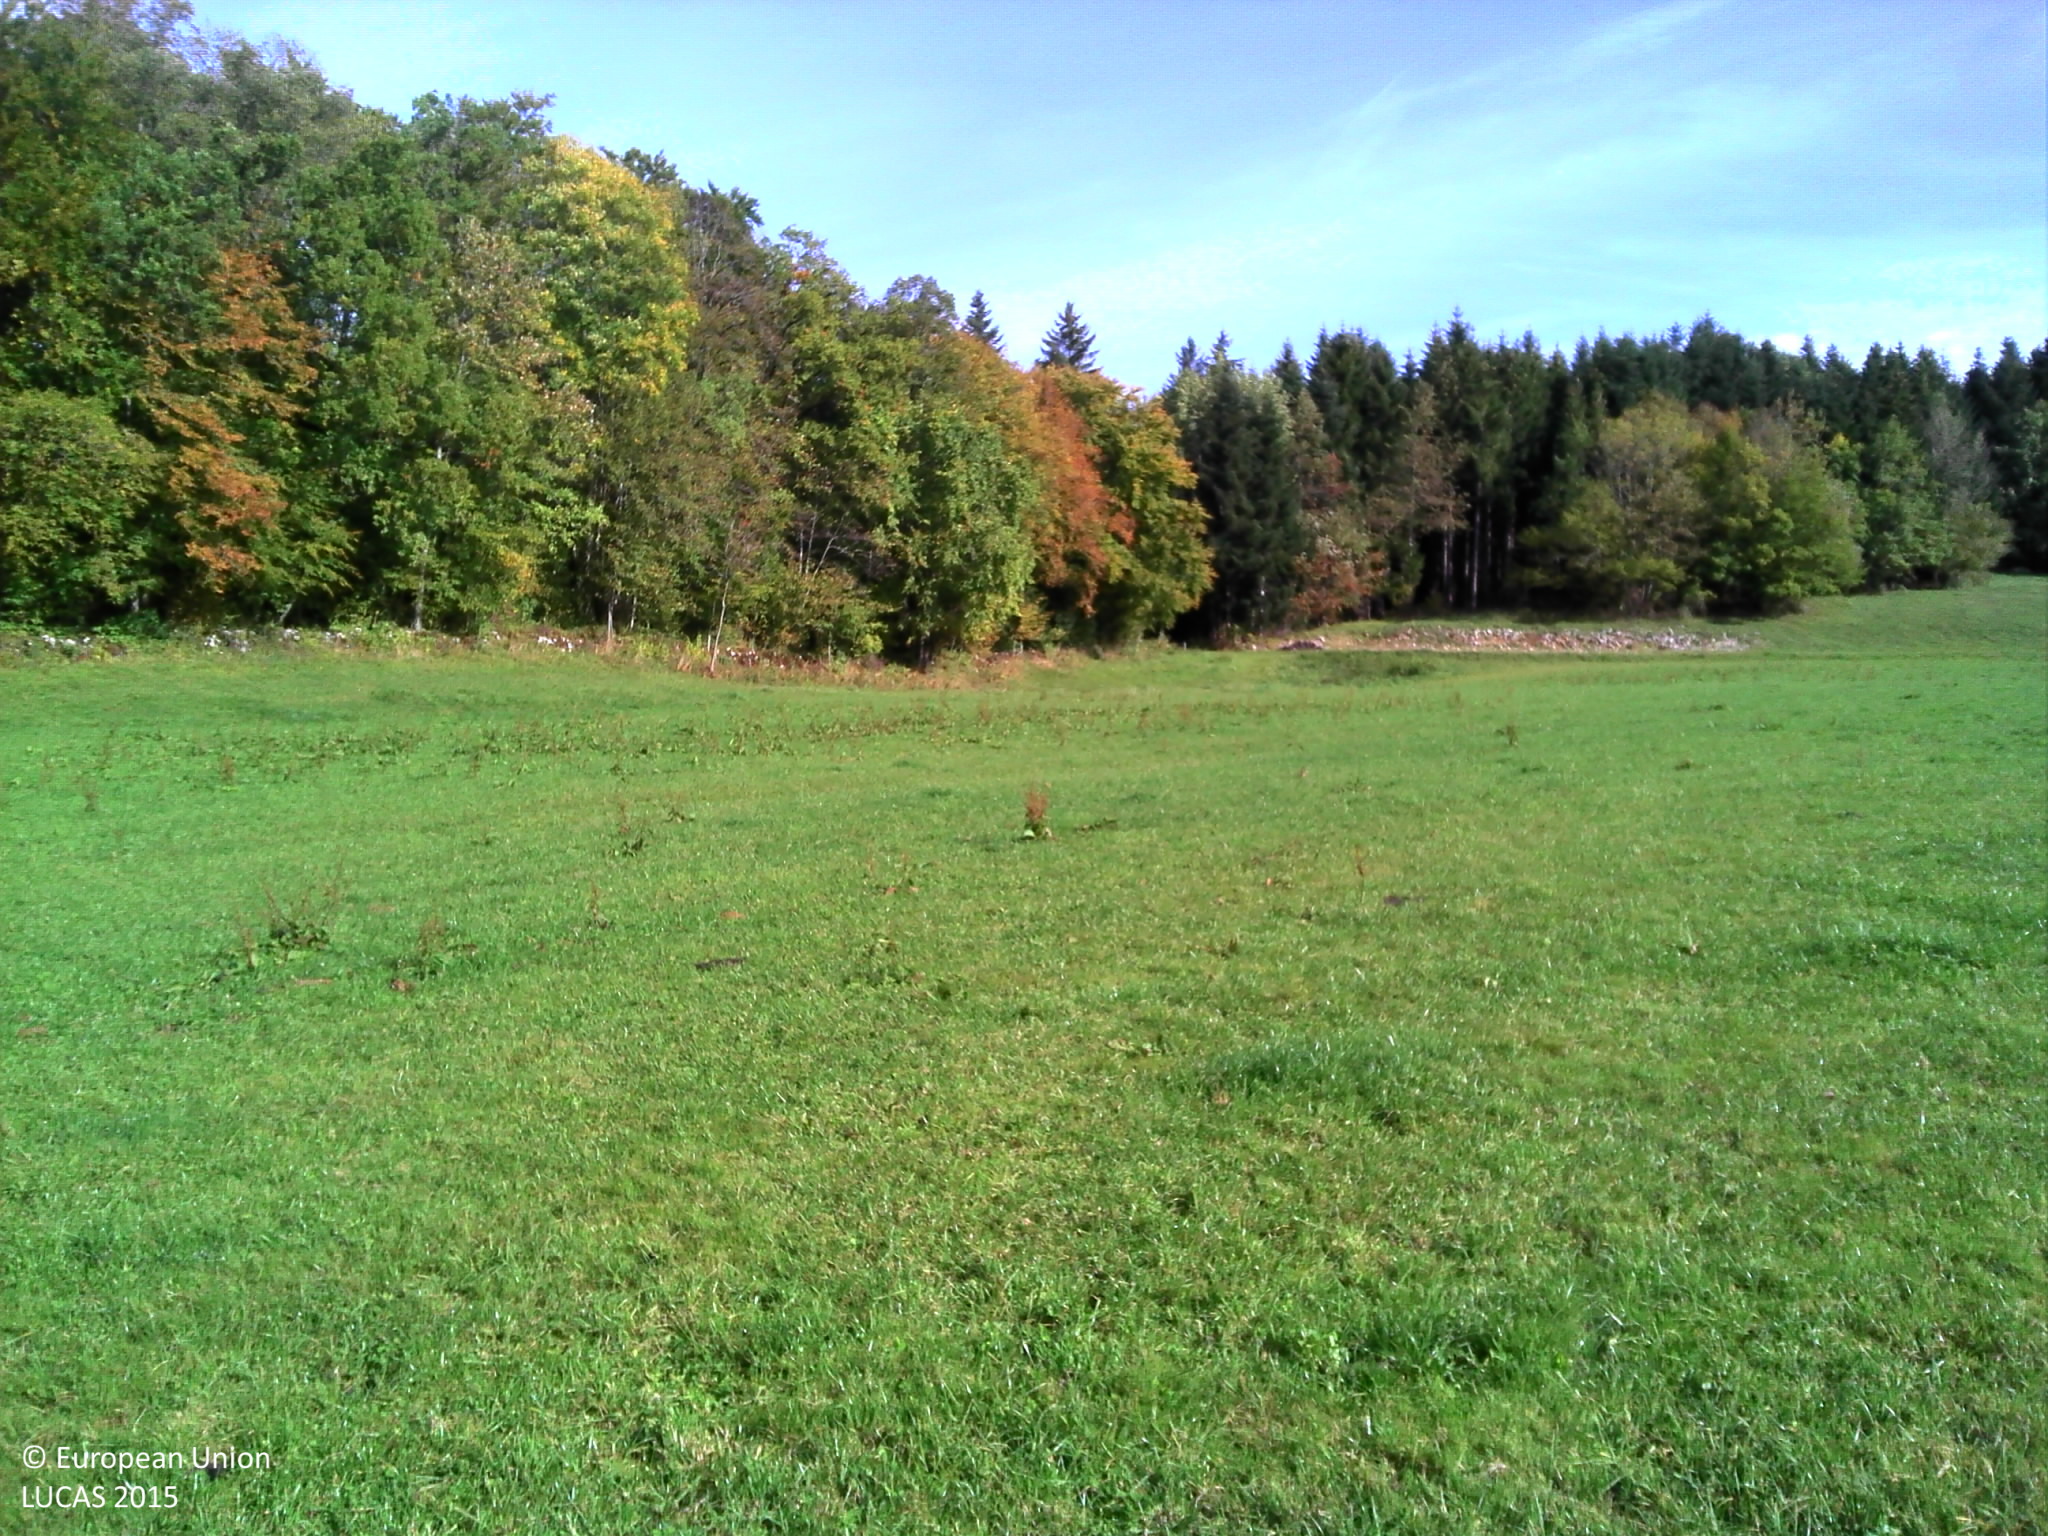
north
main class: Grassland
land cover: Grassland without tree/shrub cover
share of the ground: > 75 %
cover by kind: herbaceous plants 100 %
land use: Agriculture (excluding fallow land and kitchen gardens)
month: October
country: FR
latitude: 47.0625
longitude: 6.3024
